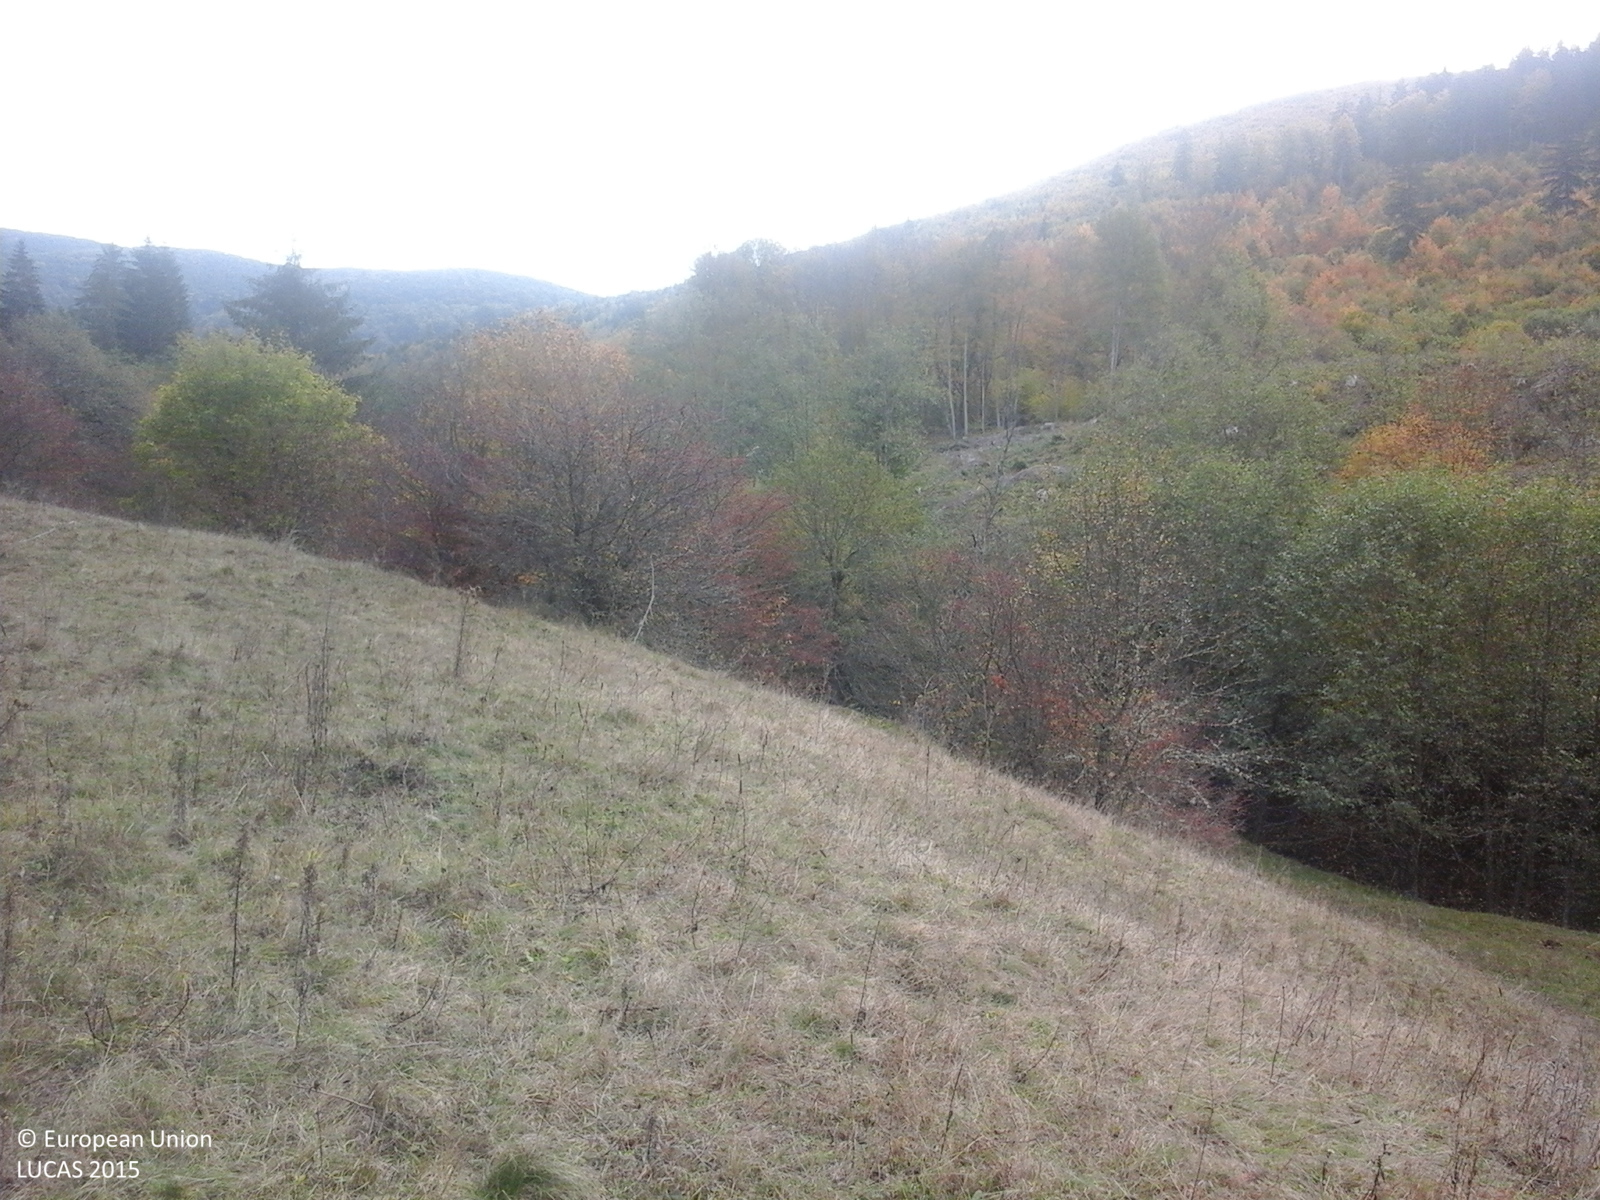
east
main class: Grassland
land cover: Grassland without tree/shrub cover
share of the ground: > 75 %
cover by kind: herbaceous plants 100 %
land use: Agriculture (excluding fallow land and kitchen gardens)
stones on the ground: < 10 %
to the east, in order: Grassland without tree/shrub cover; Abandoned hedges; Tracks; Abandoned hedges; Rivers and streams; Abandoned hedges; Tracks; Shrubland without tree cover
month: October
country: RO
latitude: 46.1475
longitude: 26.1104
